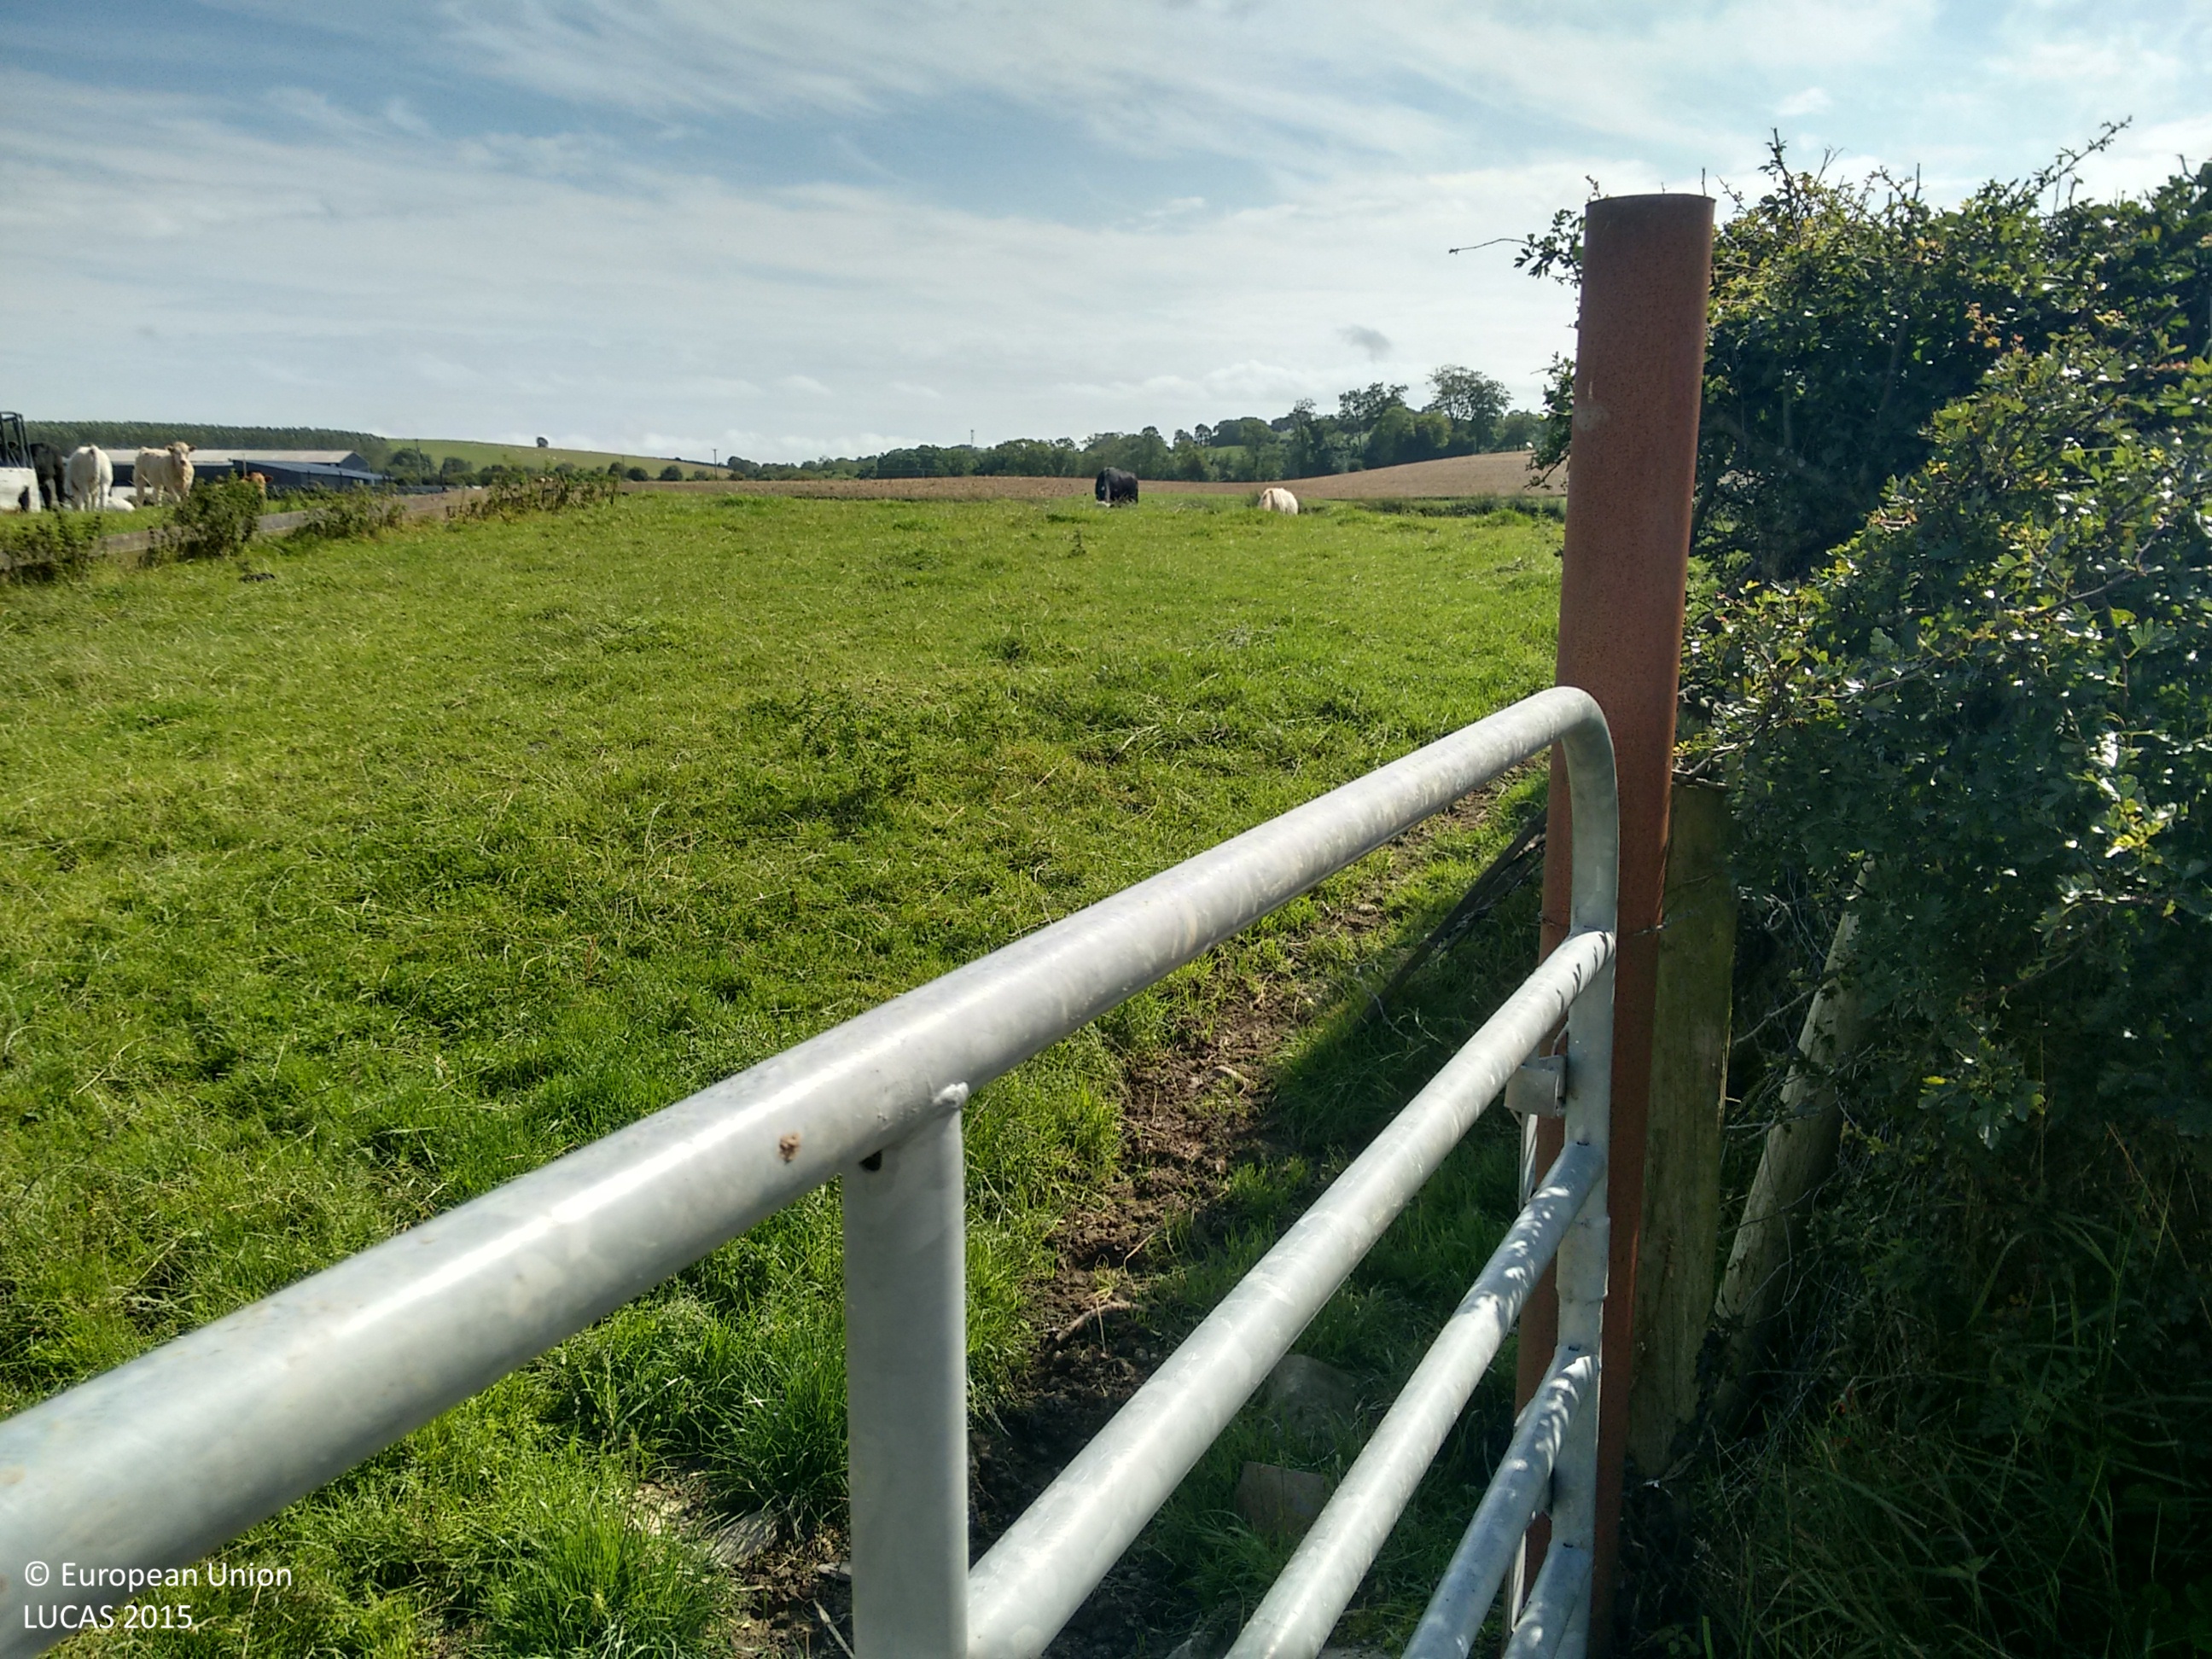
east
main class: Grassland
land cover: Grassland without tree/shrub cover
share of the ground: > 75 %
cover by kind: herbaceous plants 100 %
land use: Agriculture (excluding fallow land and kitchen gardens)
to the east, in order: Grassland without tree/shrub cover; Fences; Abandoned hedges; Grassland without tree/shrub cover
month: August
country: GB
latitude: 54.4425
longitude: -5.6911
